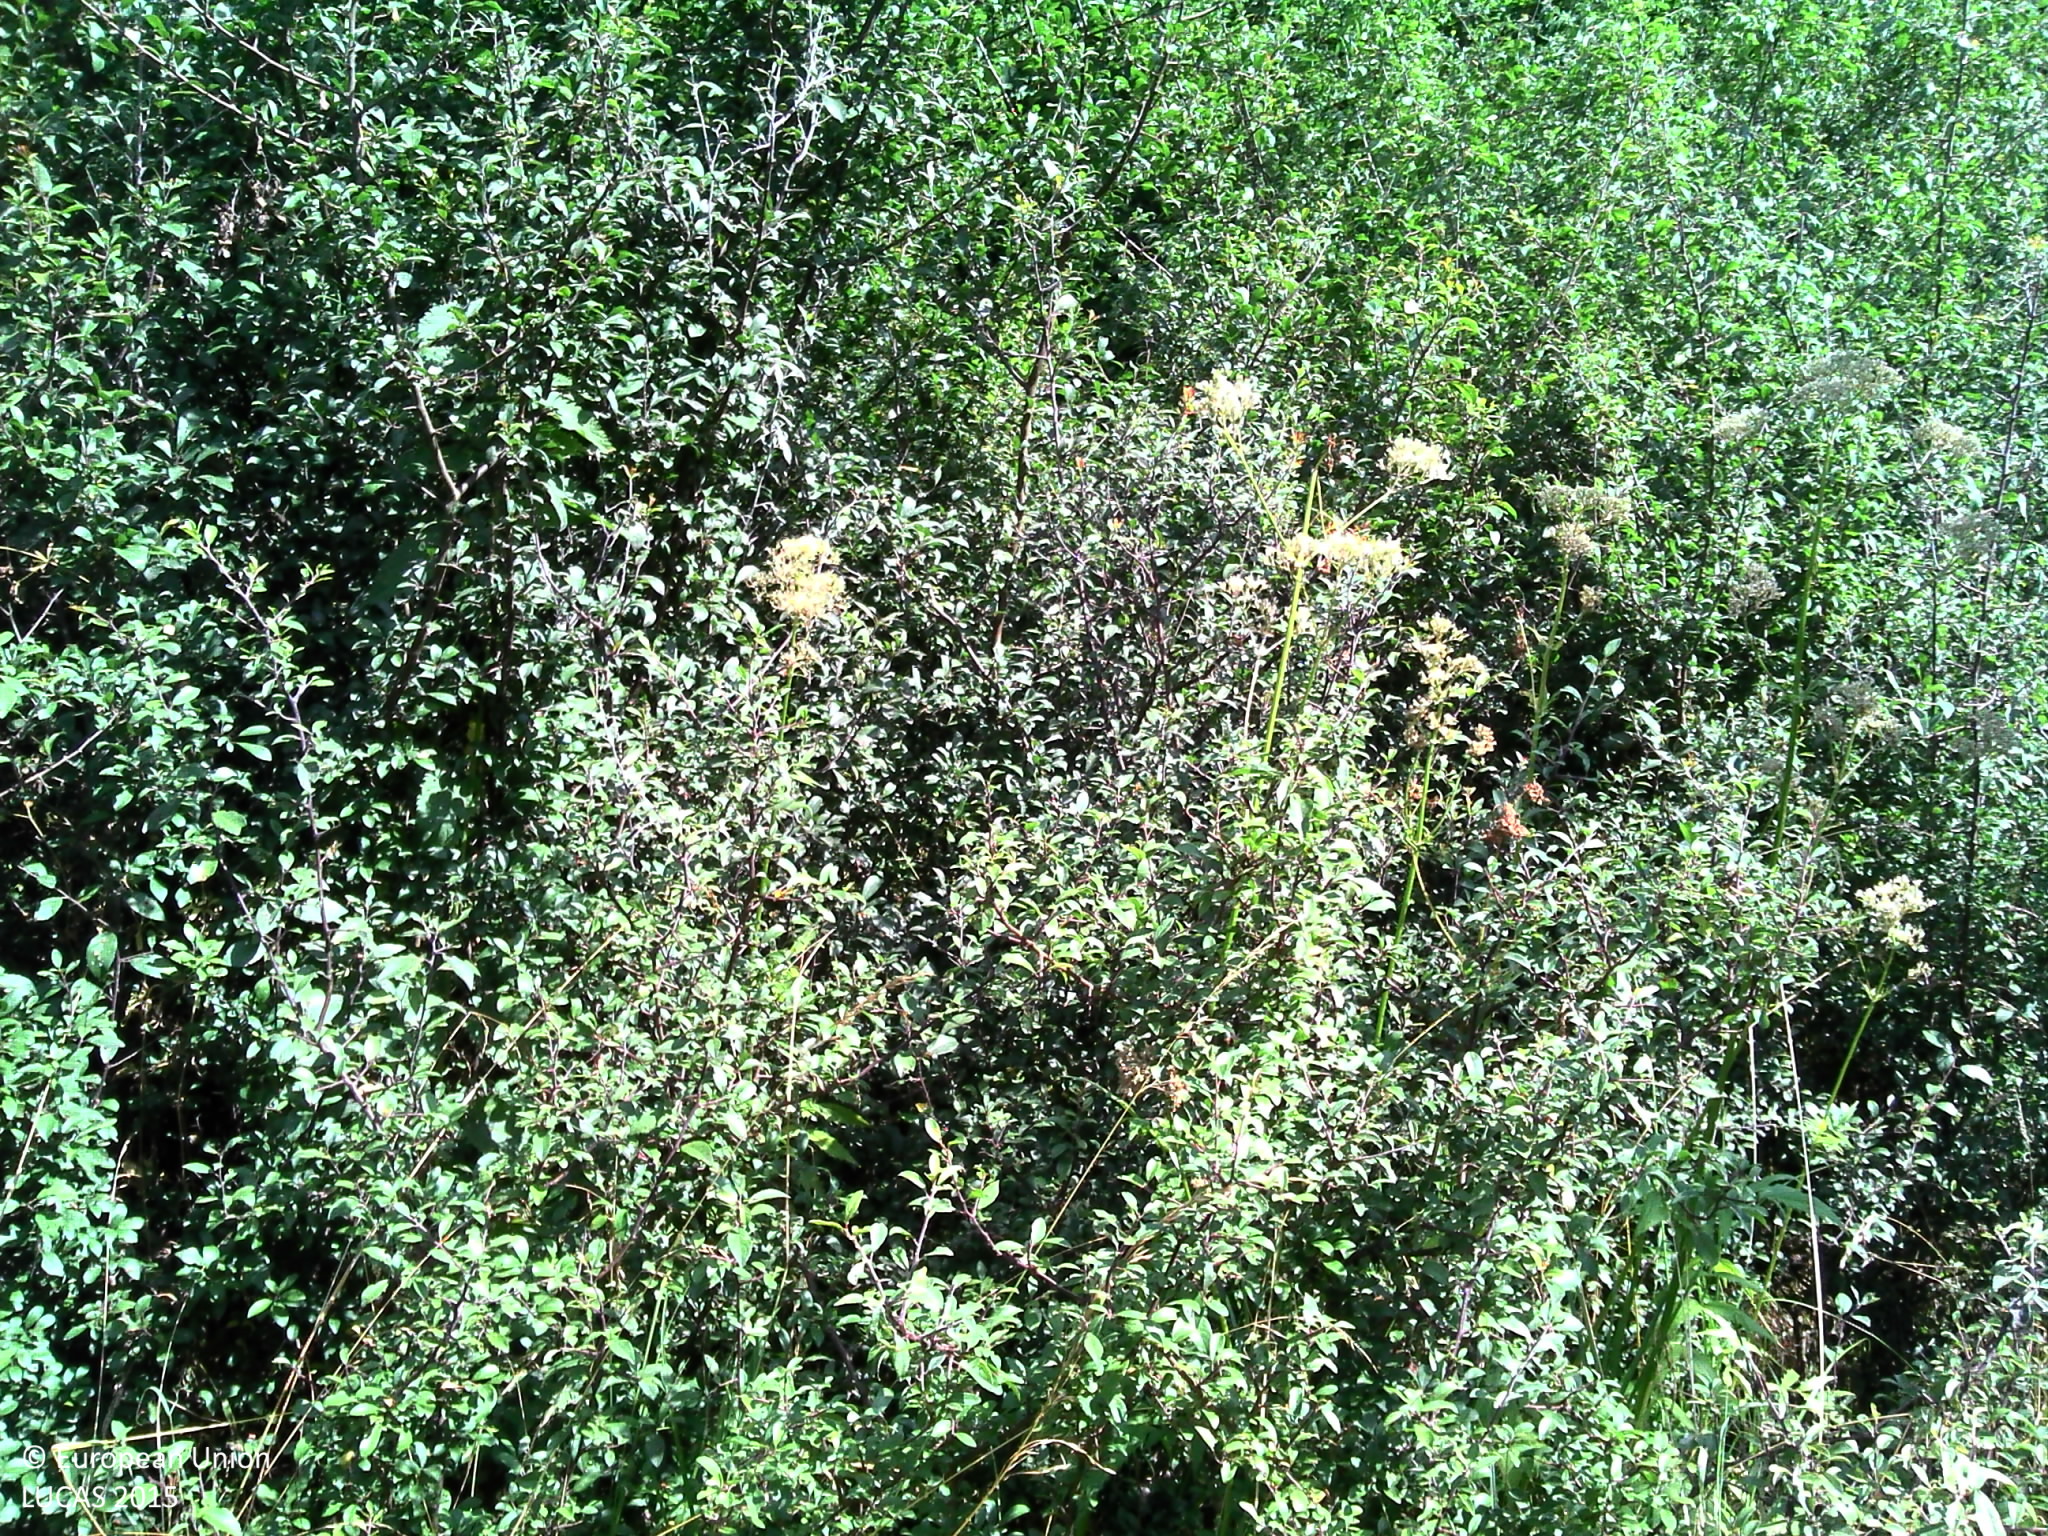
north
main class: Shrubland
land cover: Shrubland with sparse tree cover
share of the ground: 50 - 75 %
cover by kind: shrubs 60 %, herbaceous plants 35 %, broadleaved forest trees 5 %
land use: Forestry
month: July
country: BE
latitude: 49.7286
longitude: 5.7954
